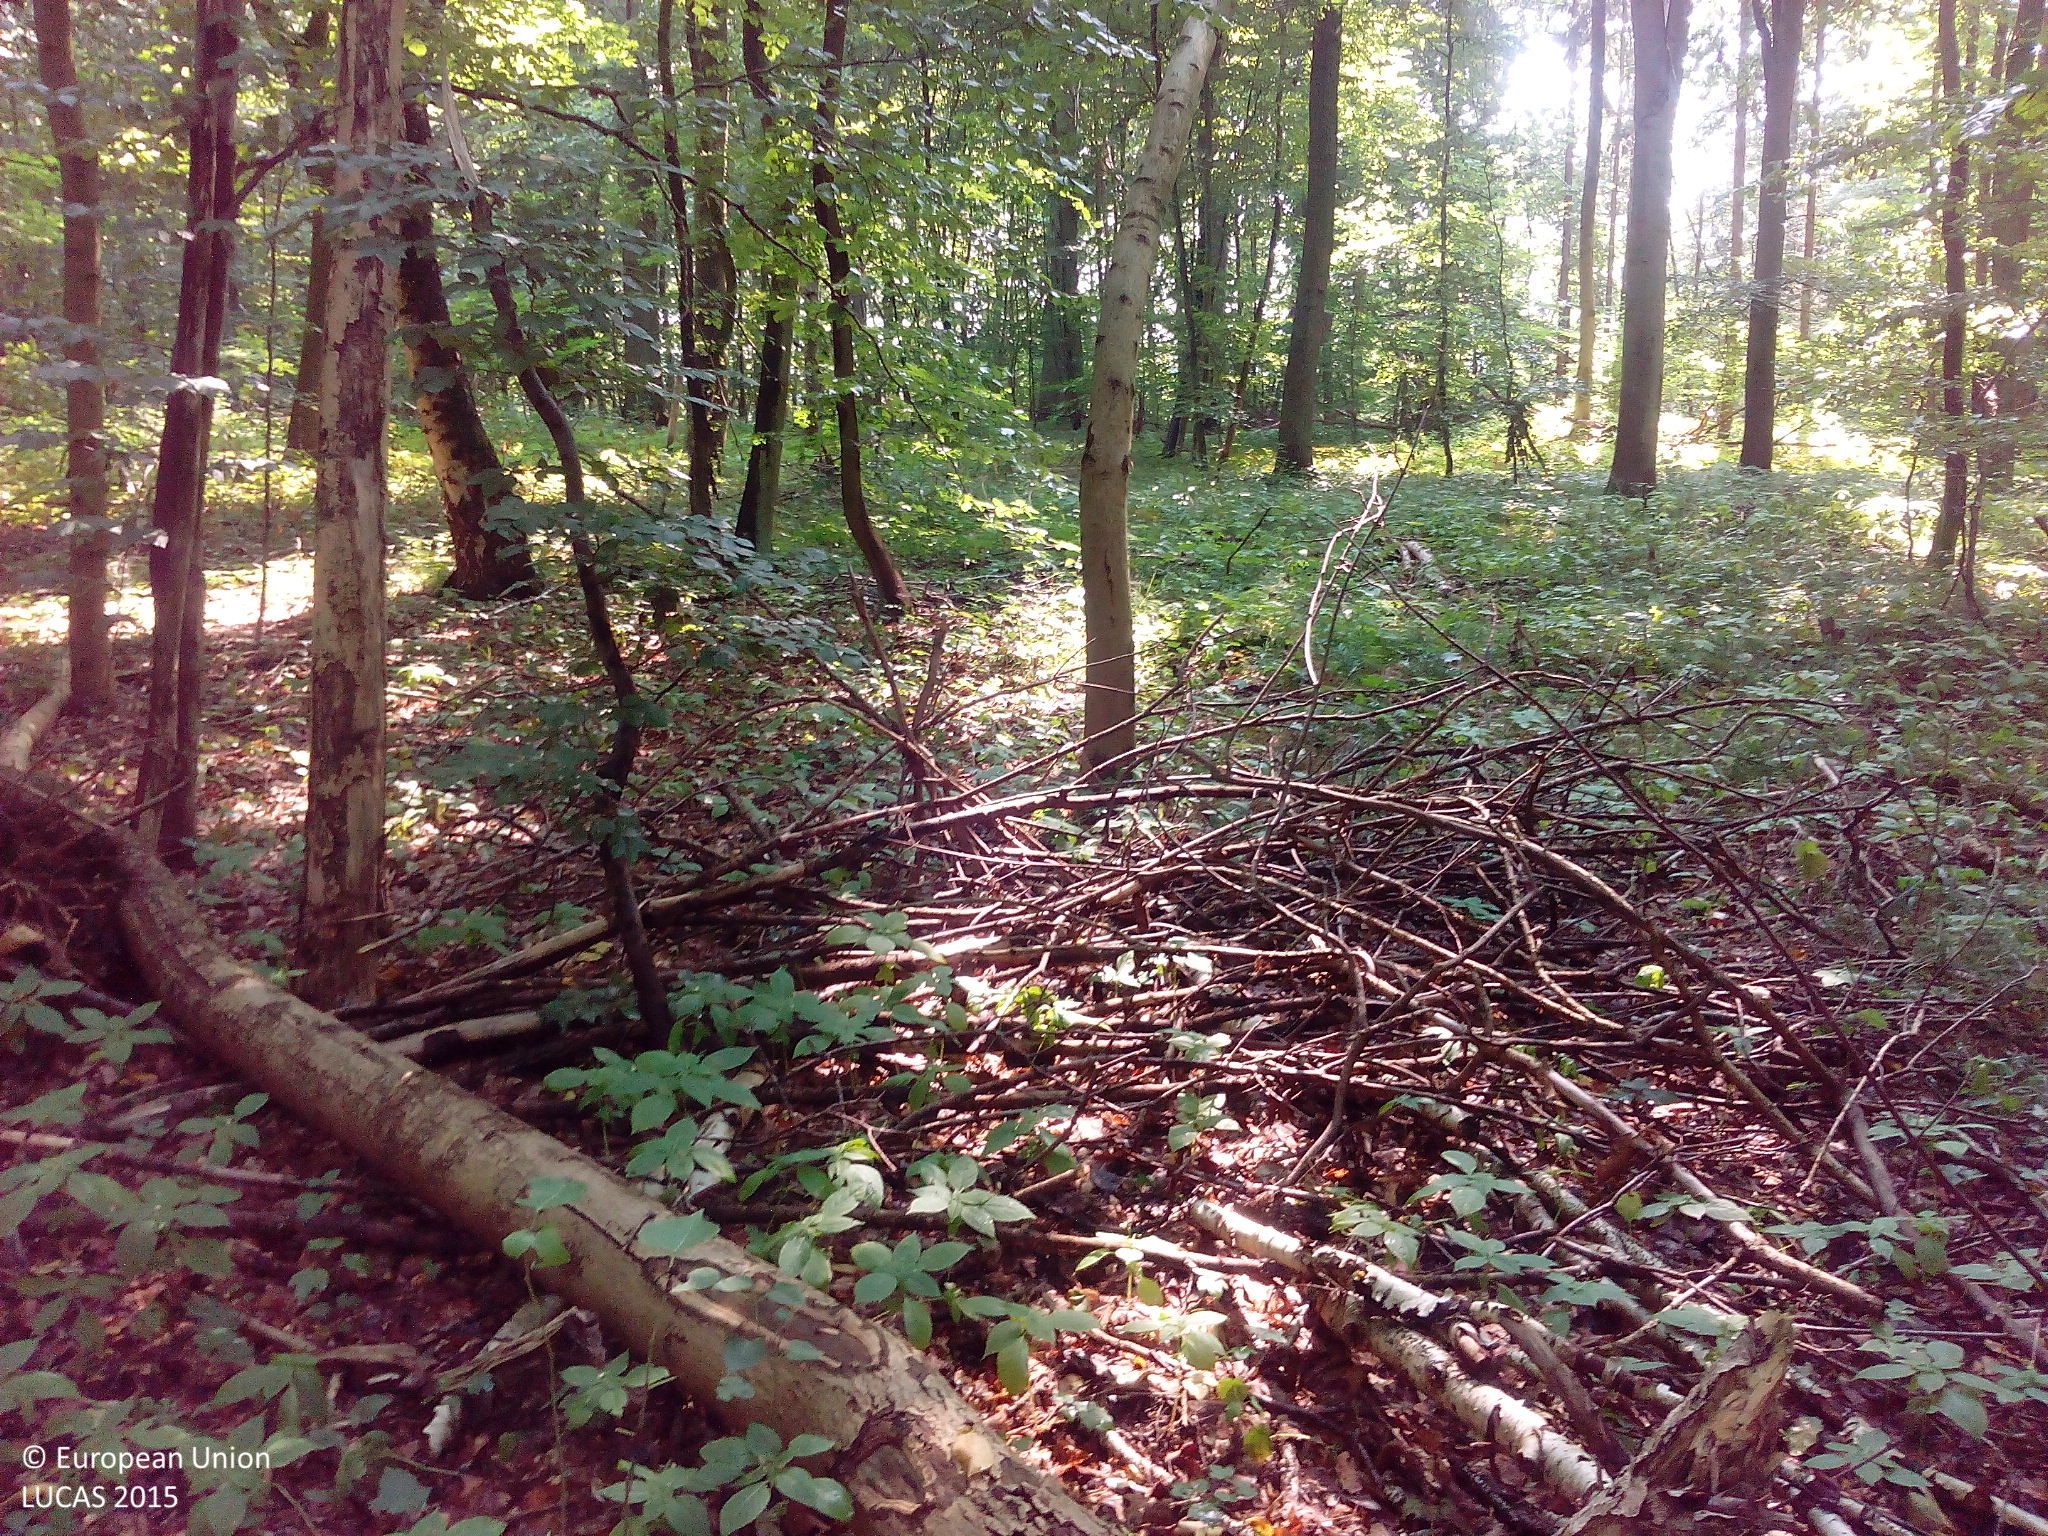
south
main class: Woodland
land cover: Broadleaved woodland
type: mesophytic deciduous forest
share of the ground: > 75 %
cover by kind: broadleaved forest trees 95 %, herbaceous plants 5 %
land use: Forestry
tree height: > 5 m
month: August
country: DE
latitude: 53.7938
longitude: 12.2915
